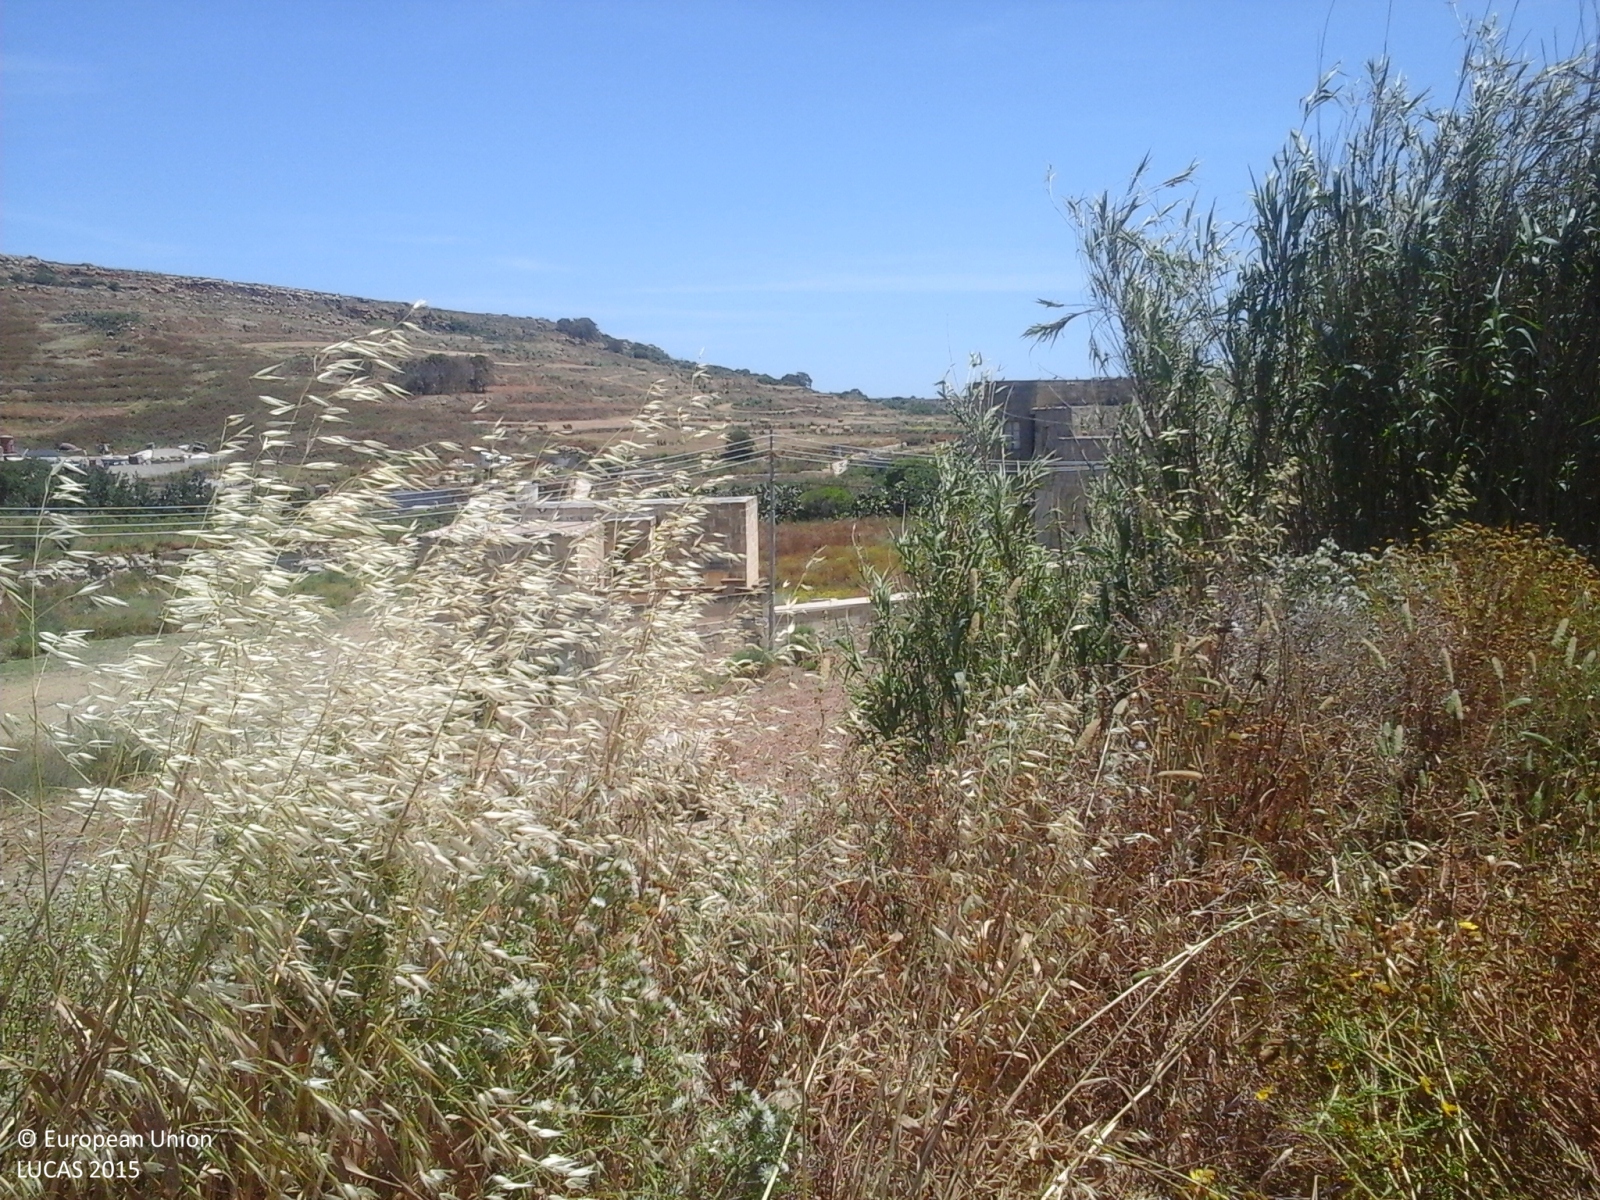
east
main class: Grassland
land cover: Spontaneously vegetated surfaces
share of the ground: > 75 %
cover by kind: herbaceous plants 100 %
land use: Agriculture (excluding fallow land and kitchen gardens)
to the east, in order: Spontaneously vegetated surfaces; Grass margins; Single bushes/trees; Other leguminous and mixtures for fodder; Dry stone walls; Artificial constructions in urban areas; Shrubland with sparse tree cover; Arable land (only in case pi); Artificial constructions; Grassland without tree/shrub cover; Artificial constructions in urban areas; Single bushes/trees; Other bare soil; Grass margins; Other bare soil; Tracks; Other fruit trees and berries; Artificial constructions; Paved roads, cycling and walking lanes; Artificial constructions; Inland fresh running water
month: May
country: MT
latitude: 36.0521
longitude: 14.2352
